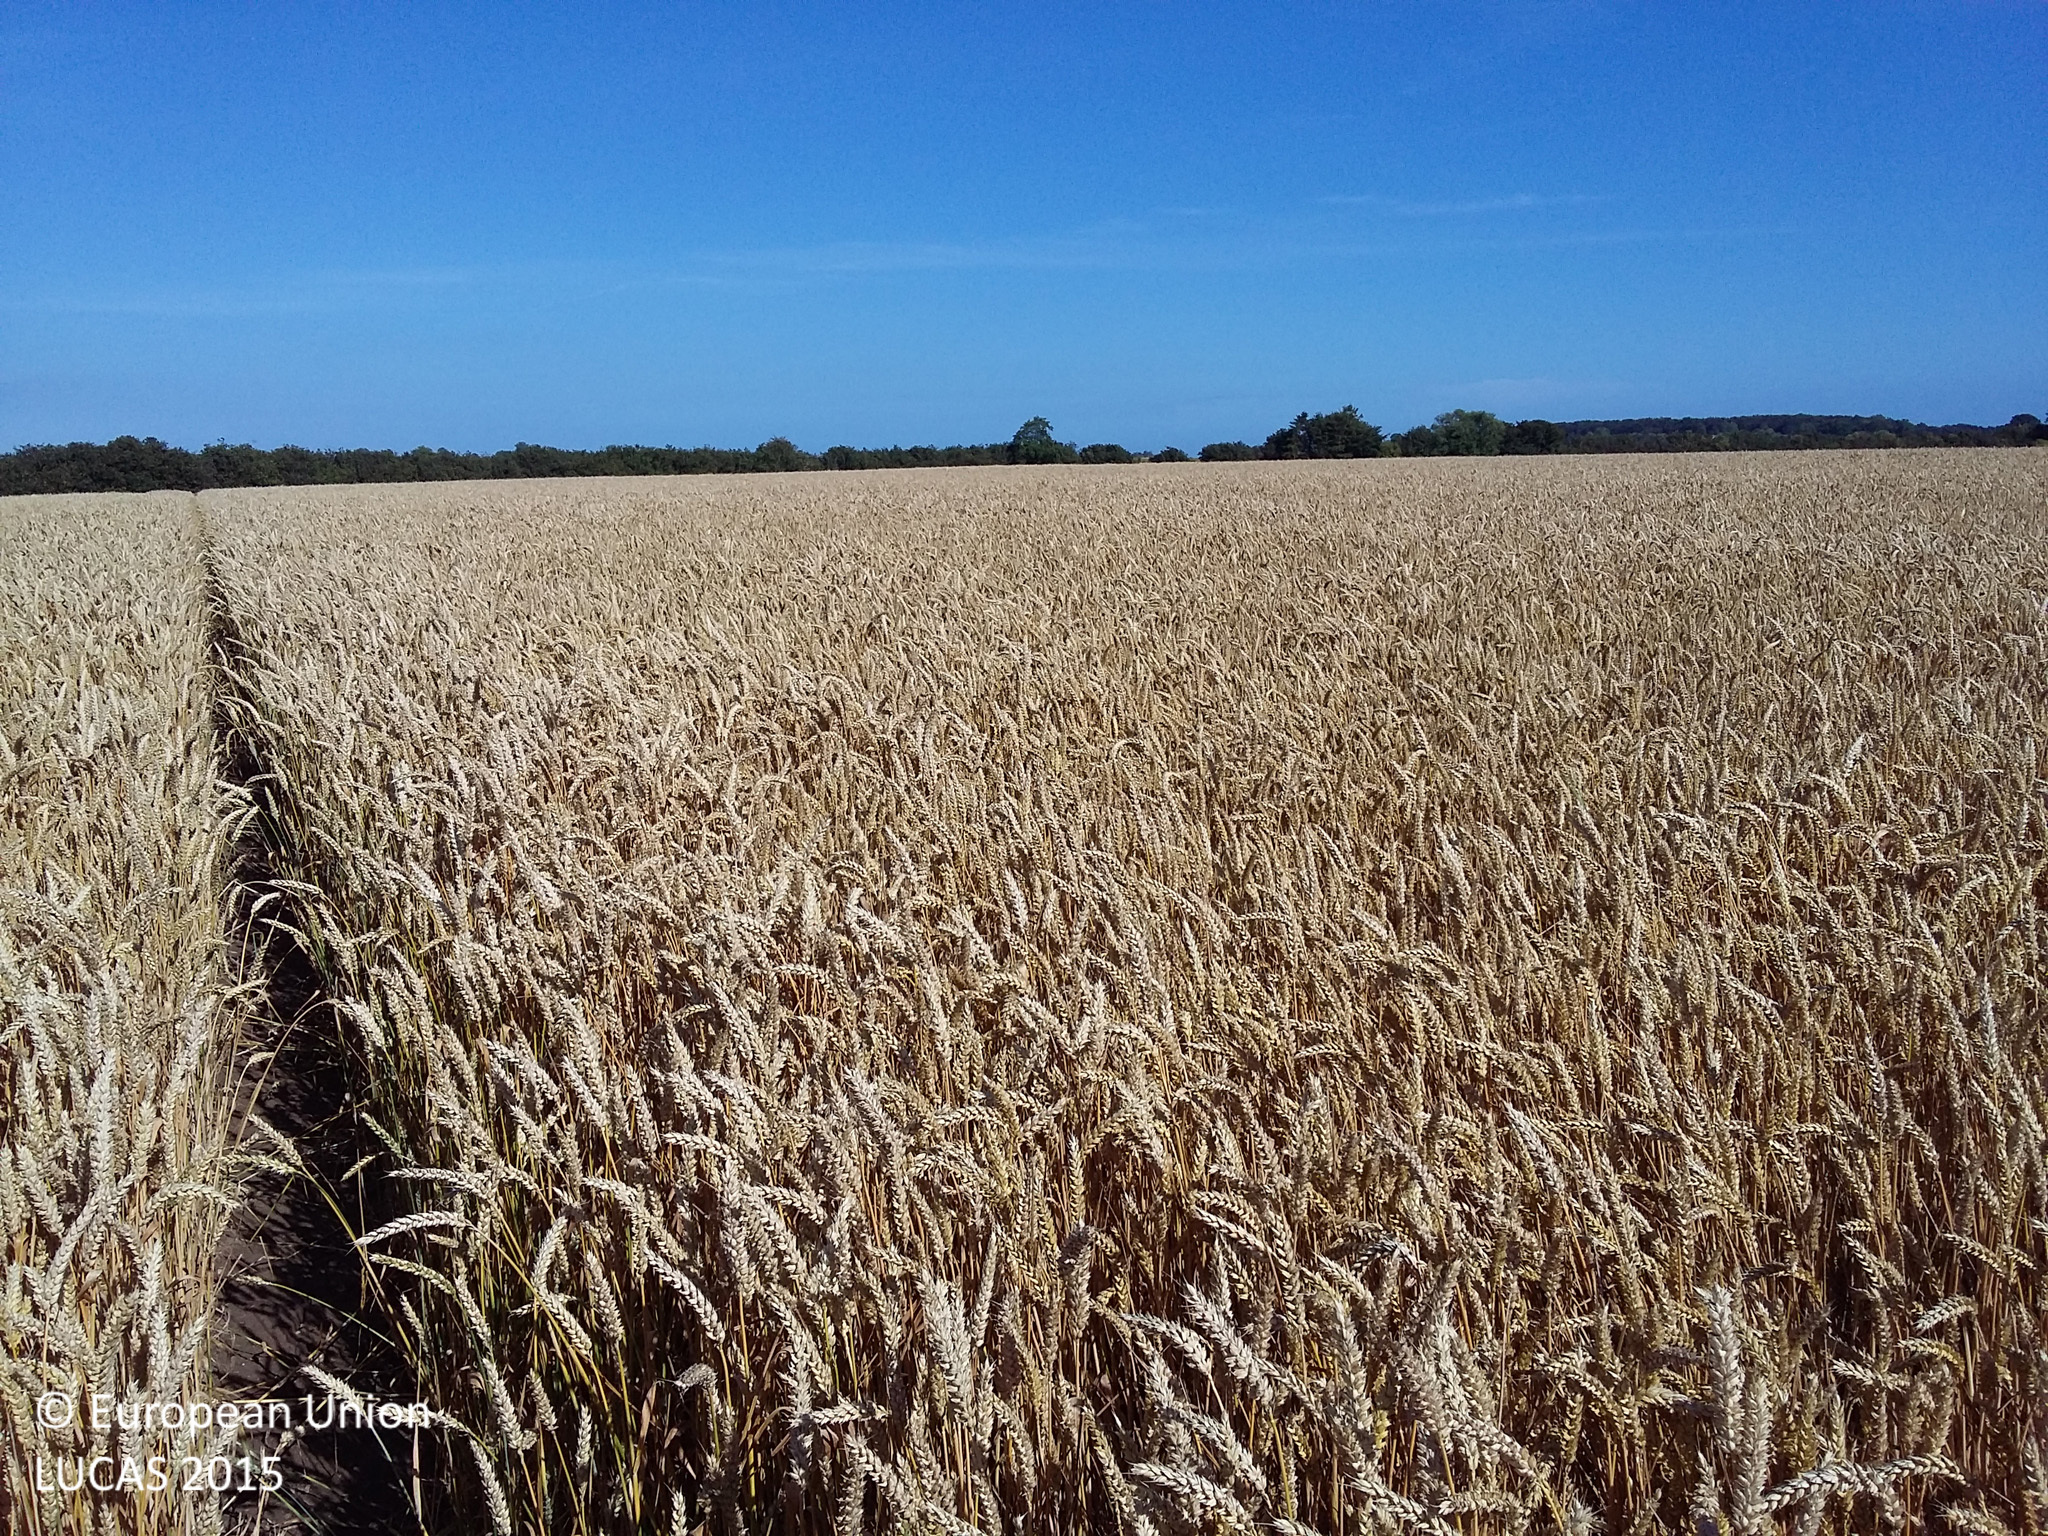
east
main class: Cropland
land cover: Common wheat
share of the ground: > 75 %
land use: Agriculture (excluding fallow land and kitchen gardens)
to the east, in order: Common wheat; Spontaneously vegetated surfaces; Rivers and streams; Managed hedges; Dry pulses
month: August
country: DK
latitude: 55.2499
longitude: 12.3109
